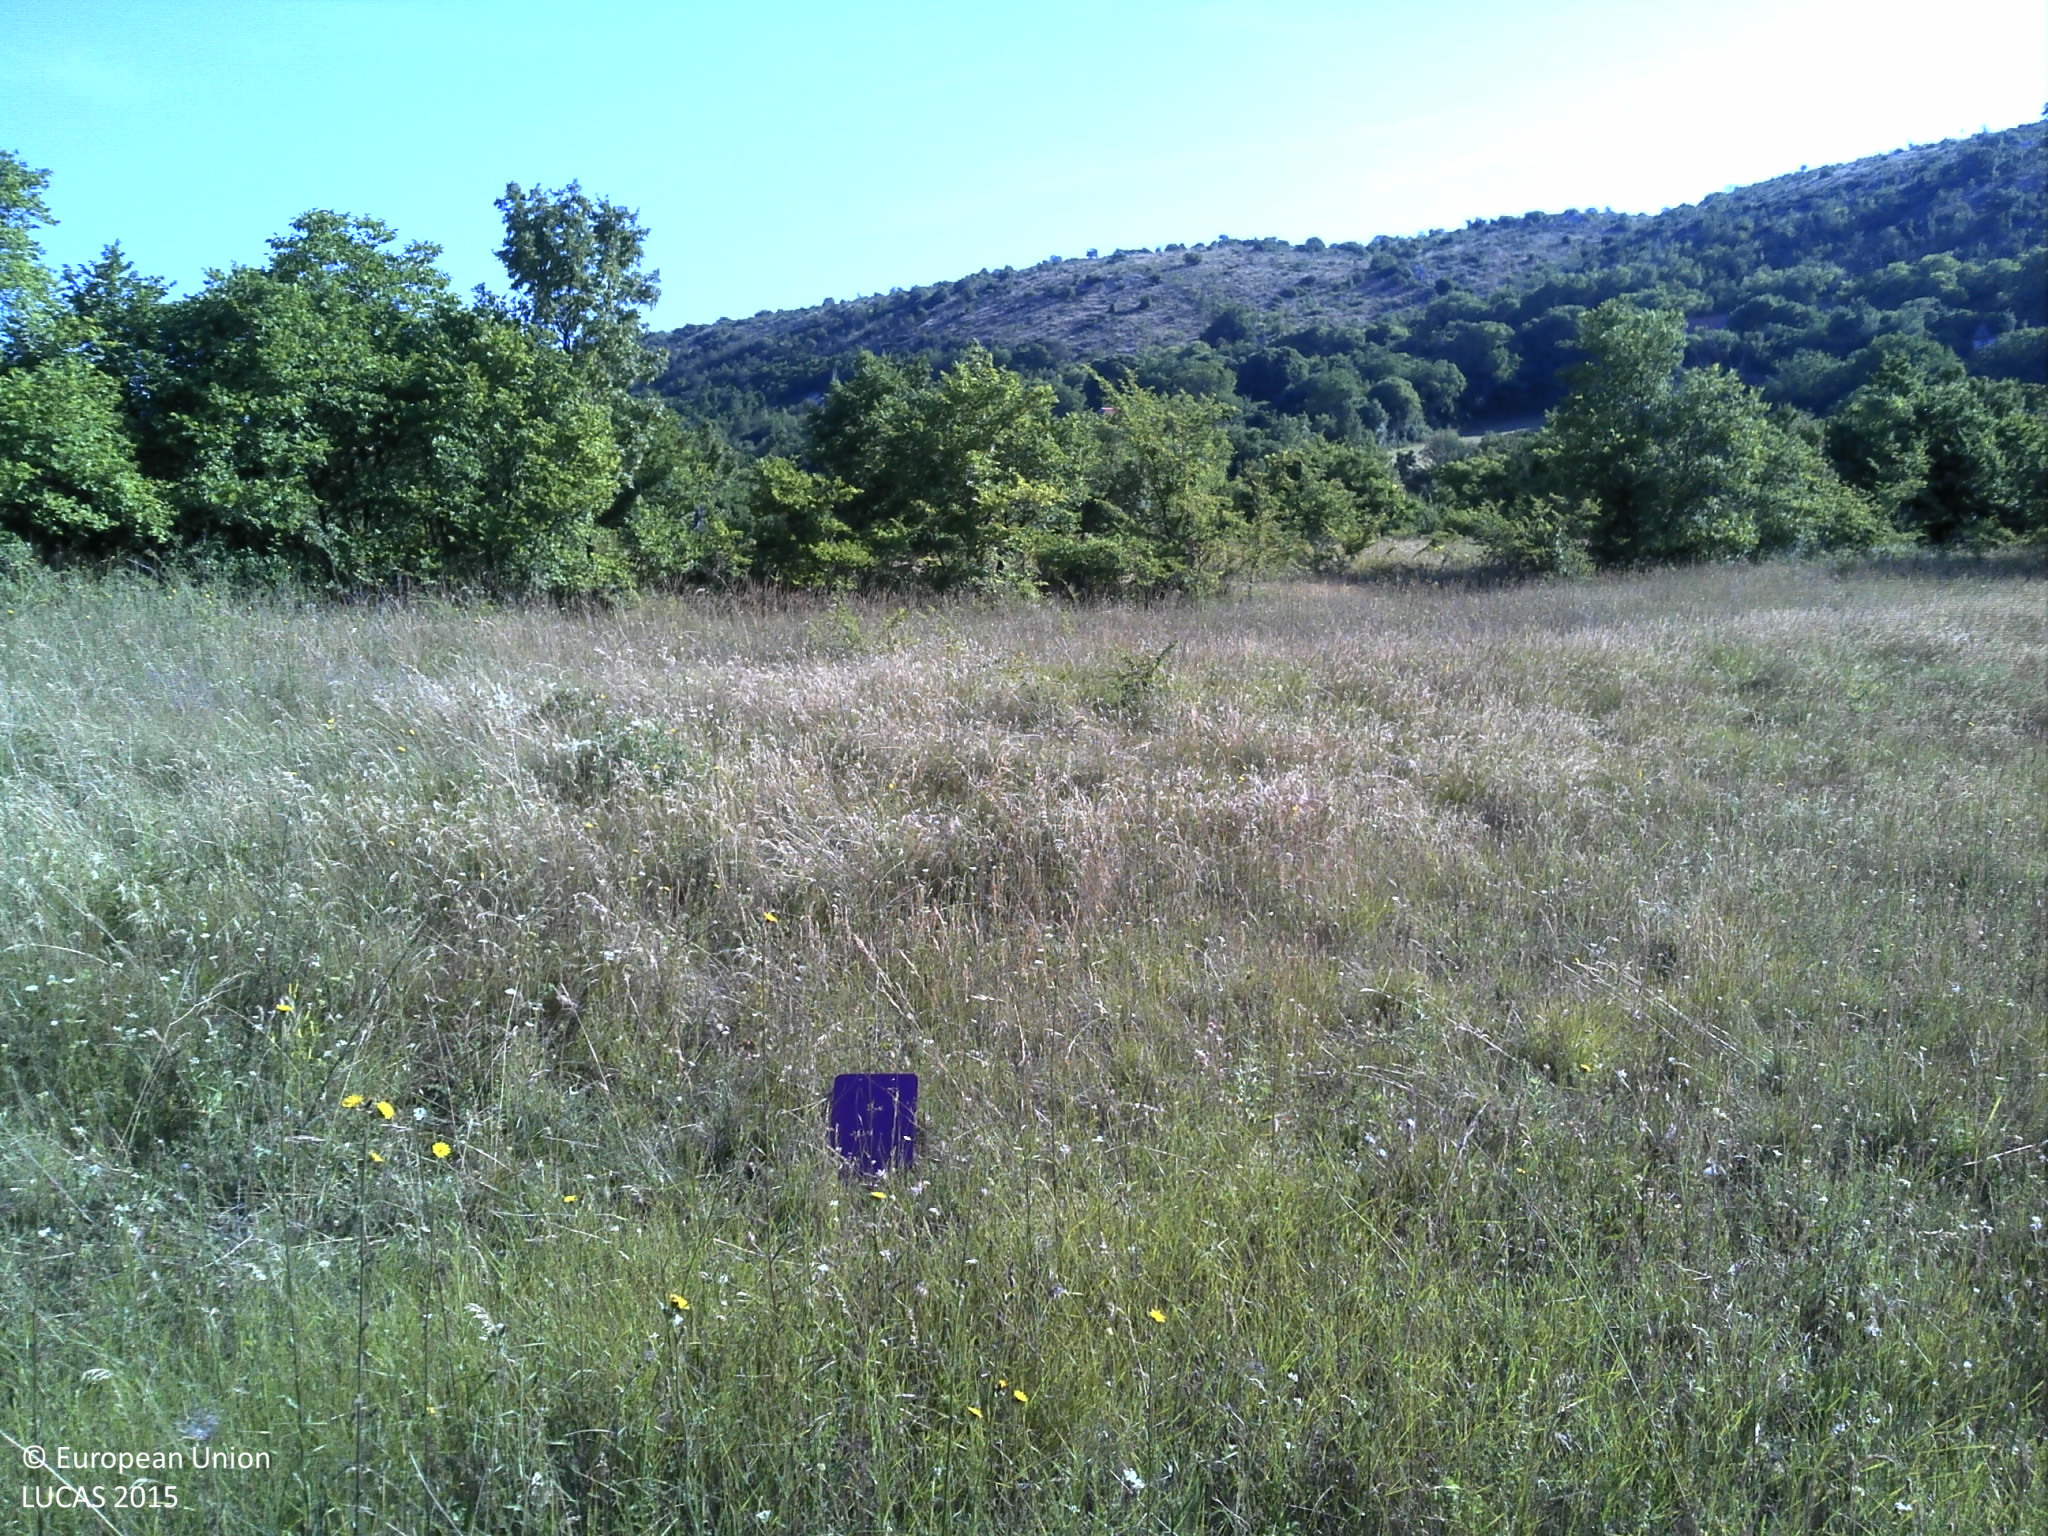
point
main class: Grassland
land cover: Grassland without tree/shrub cover
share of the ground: > 75 %
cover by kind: herbaceous plants 100 %
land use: Agriculture (excluding fallow land and kitchen gardens)
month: July
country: HR
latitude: 43.8546
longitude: 16.2495
